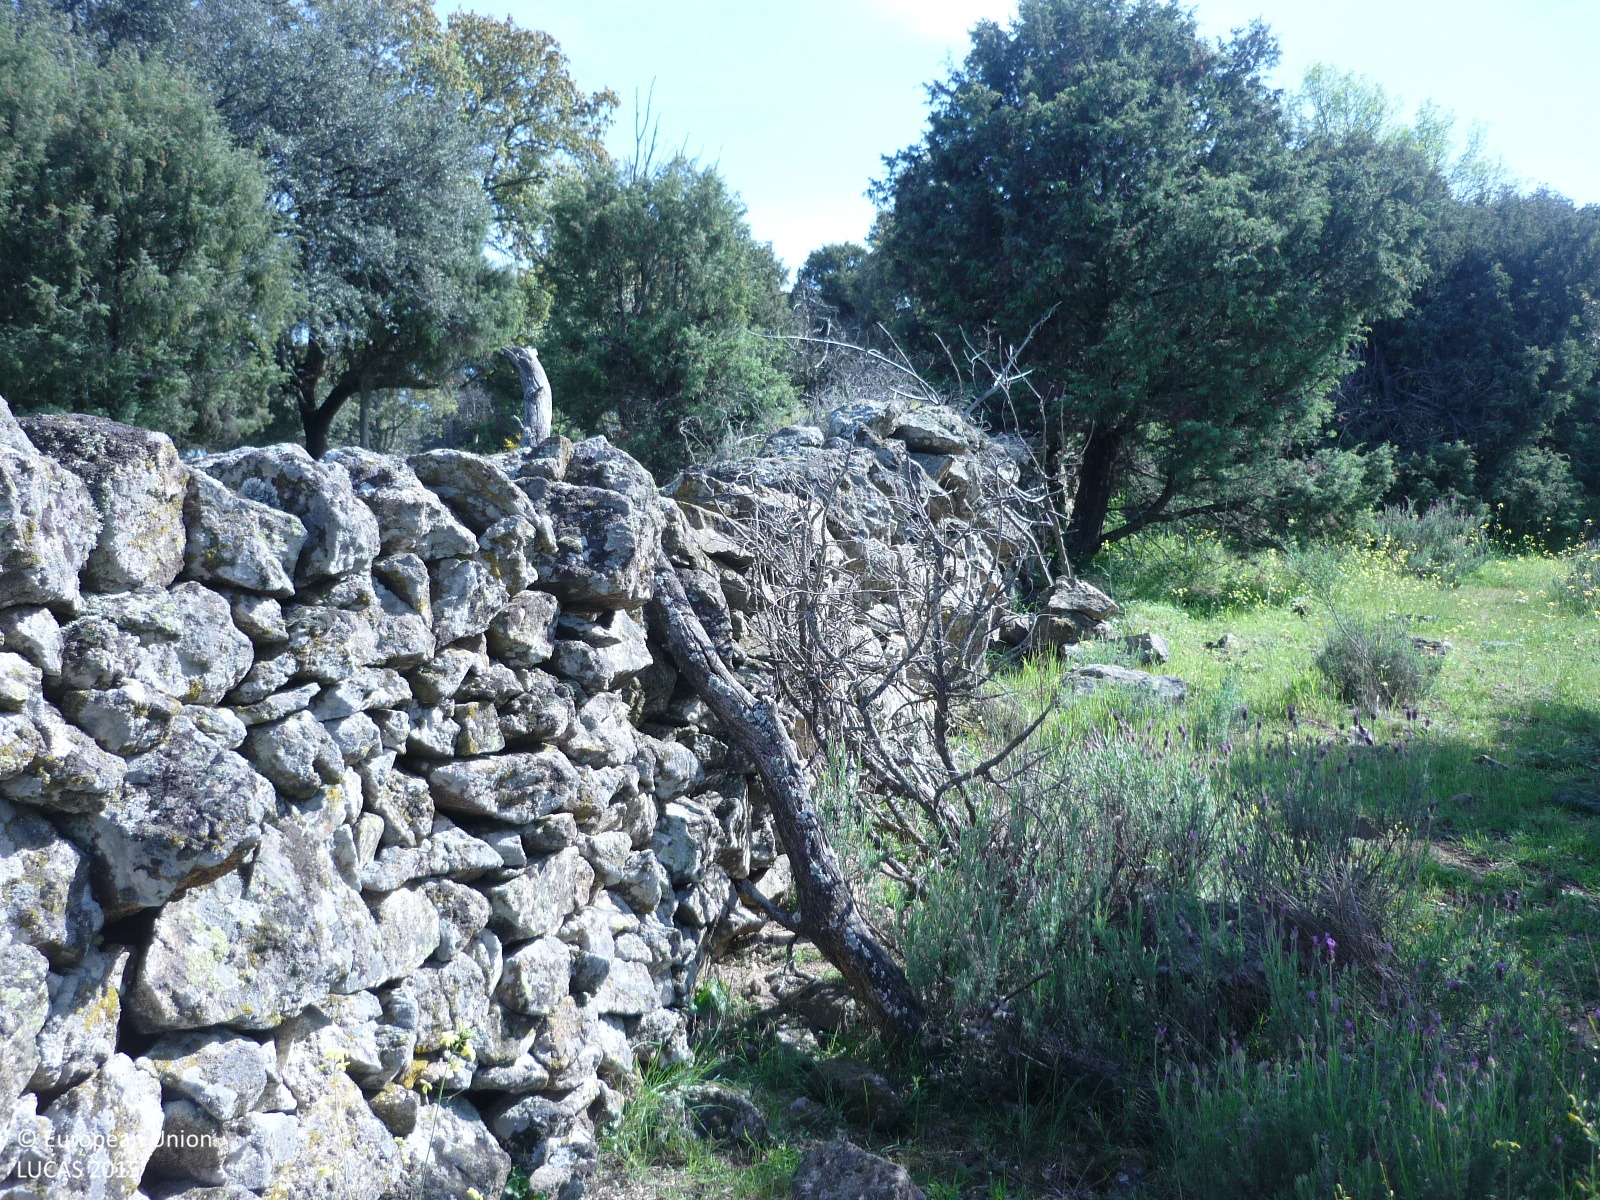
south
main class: Woodland
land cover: Broadleaved woodland
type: broadleaved evergreen forest
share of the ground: 50 - 75 %
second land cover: Grassland without tree/shrub cover
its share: > 75 %
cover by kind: broadleaved forest trees 60 %, herbaceous plants 30 %, shrubs 10 %
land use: Forestry
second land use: Agriculture (excluding fallow land and kitchen gardens)
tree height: > 5 m
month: April
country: ES
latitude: 40.7374
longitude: -3.6469
